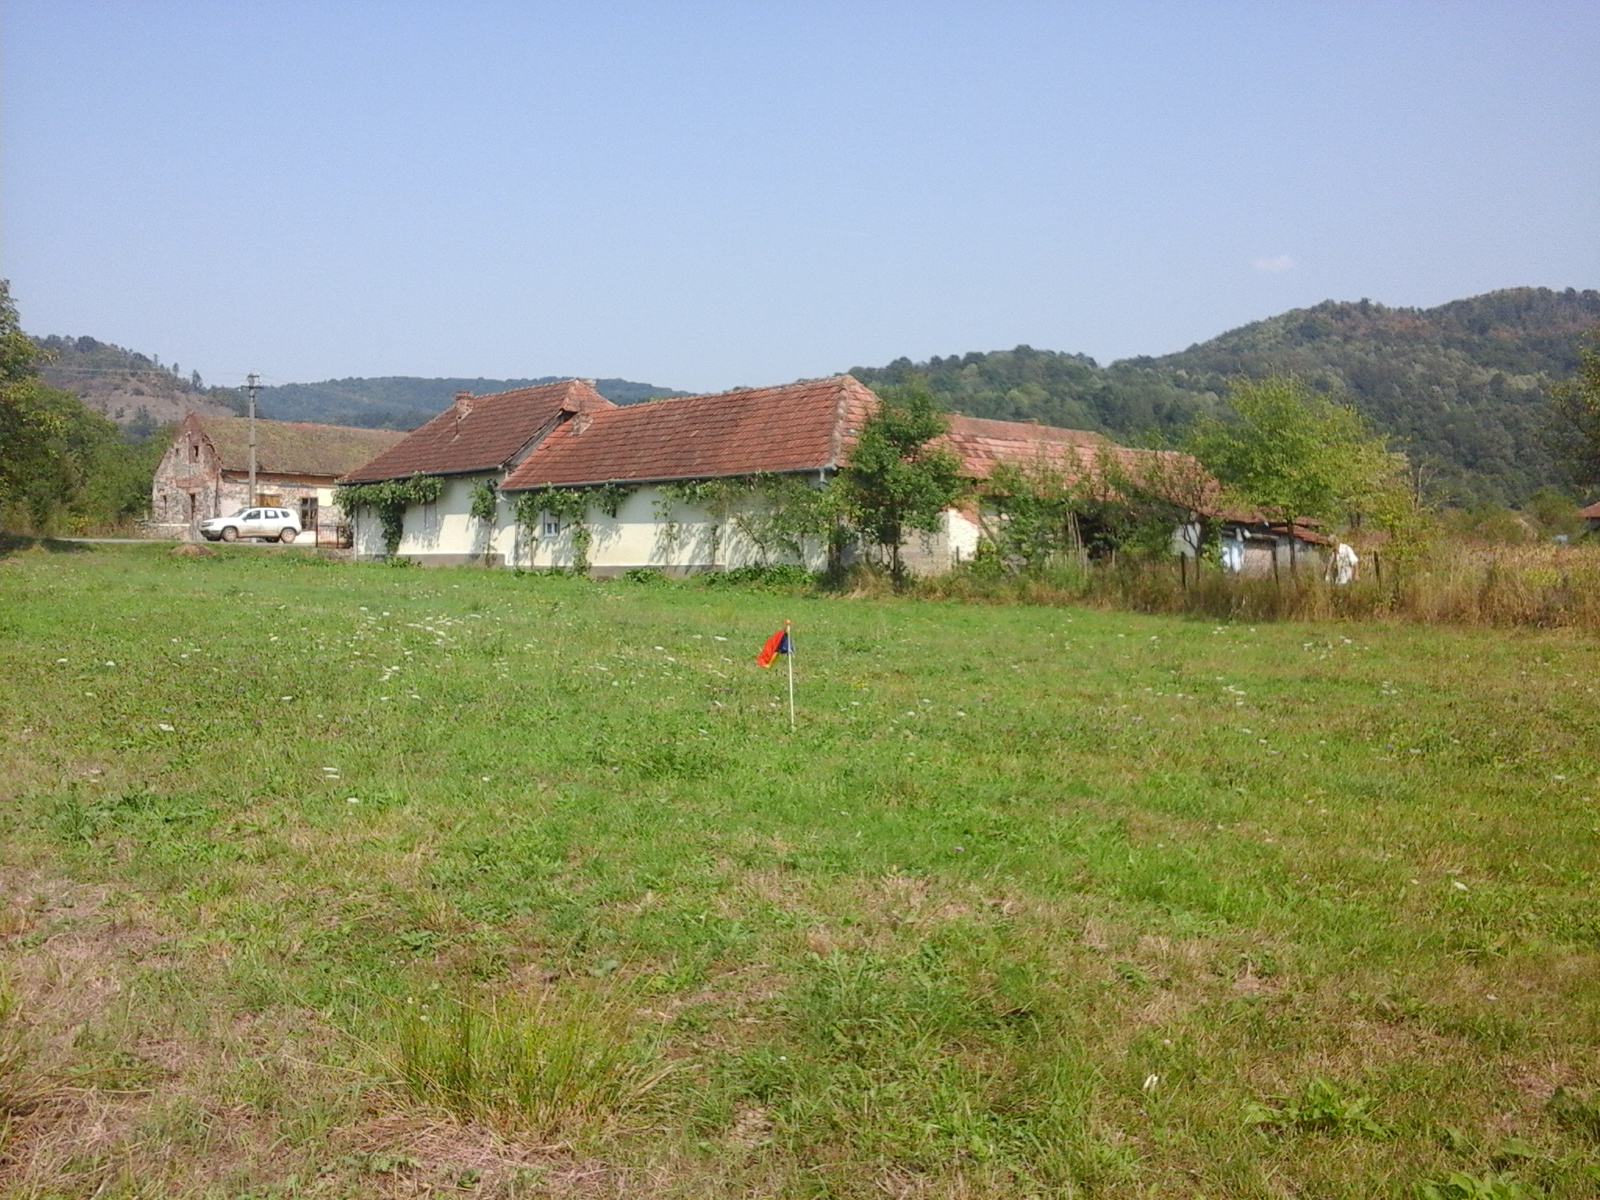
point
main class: Grassland
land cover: Grassland without tree/shrub cover
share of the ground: > 75 %
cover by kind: herbaceous plants 100 %
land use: Agriculture (excluding fallow land and kitchen gardens)
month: August
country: RO
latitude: 46.2979
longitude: 22.4212
